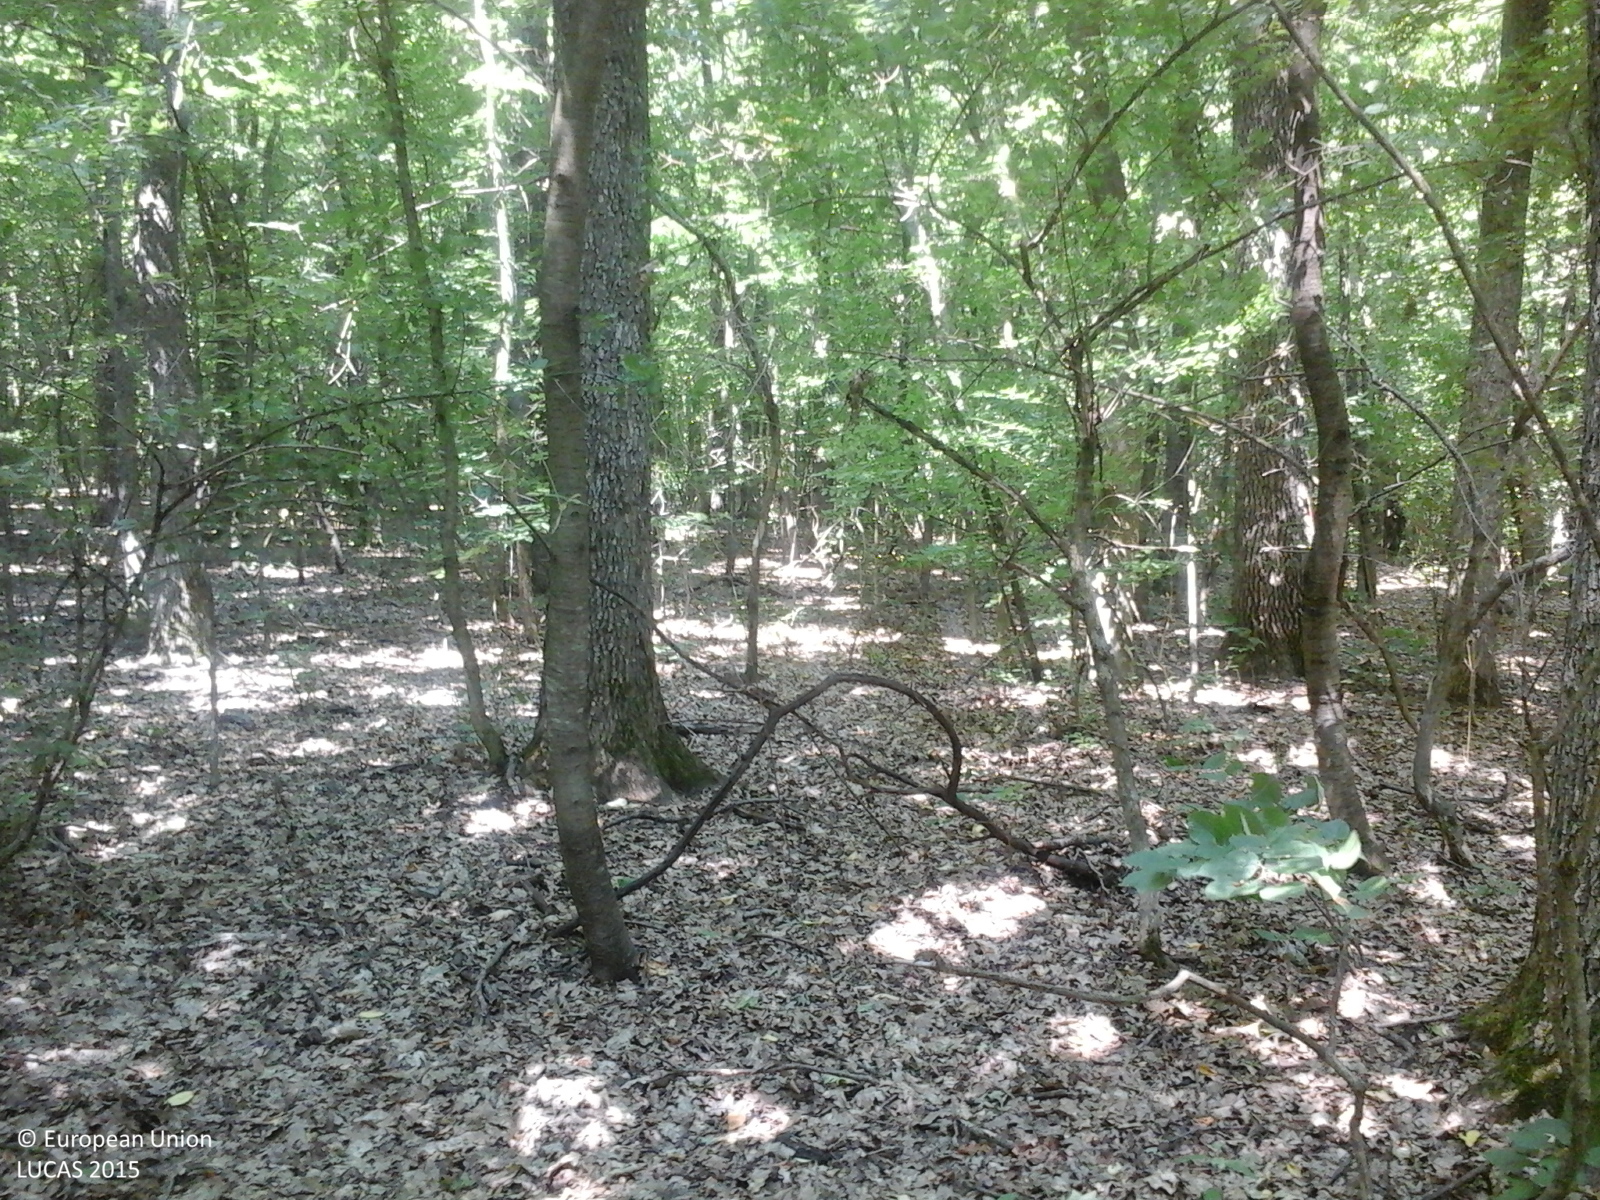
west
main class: Woodland
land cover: Broadleaved woodland
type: beech forest
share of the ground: > 75 %
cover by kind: broadleaved forest trees 100 %
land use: Forestry
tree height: > 5 m
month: June
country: RO
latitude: 46.6983
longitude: 27.2767
